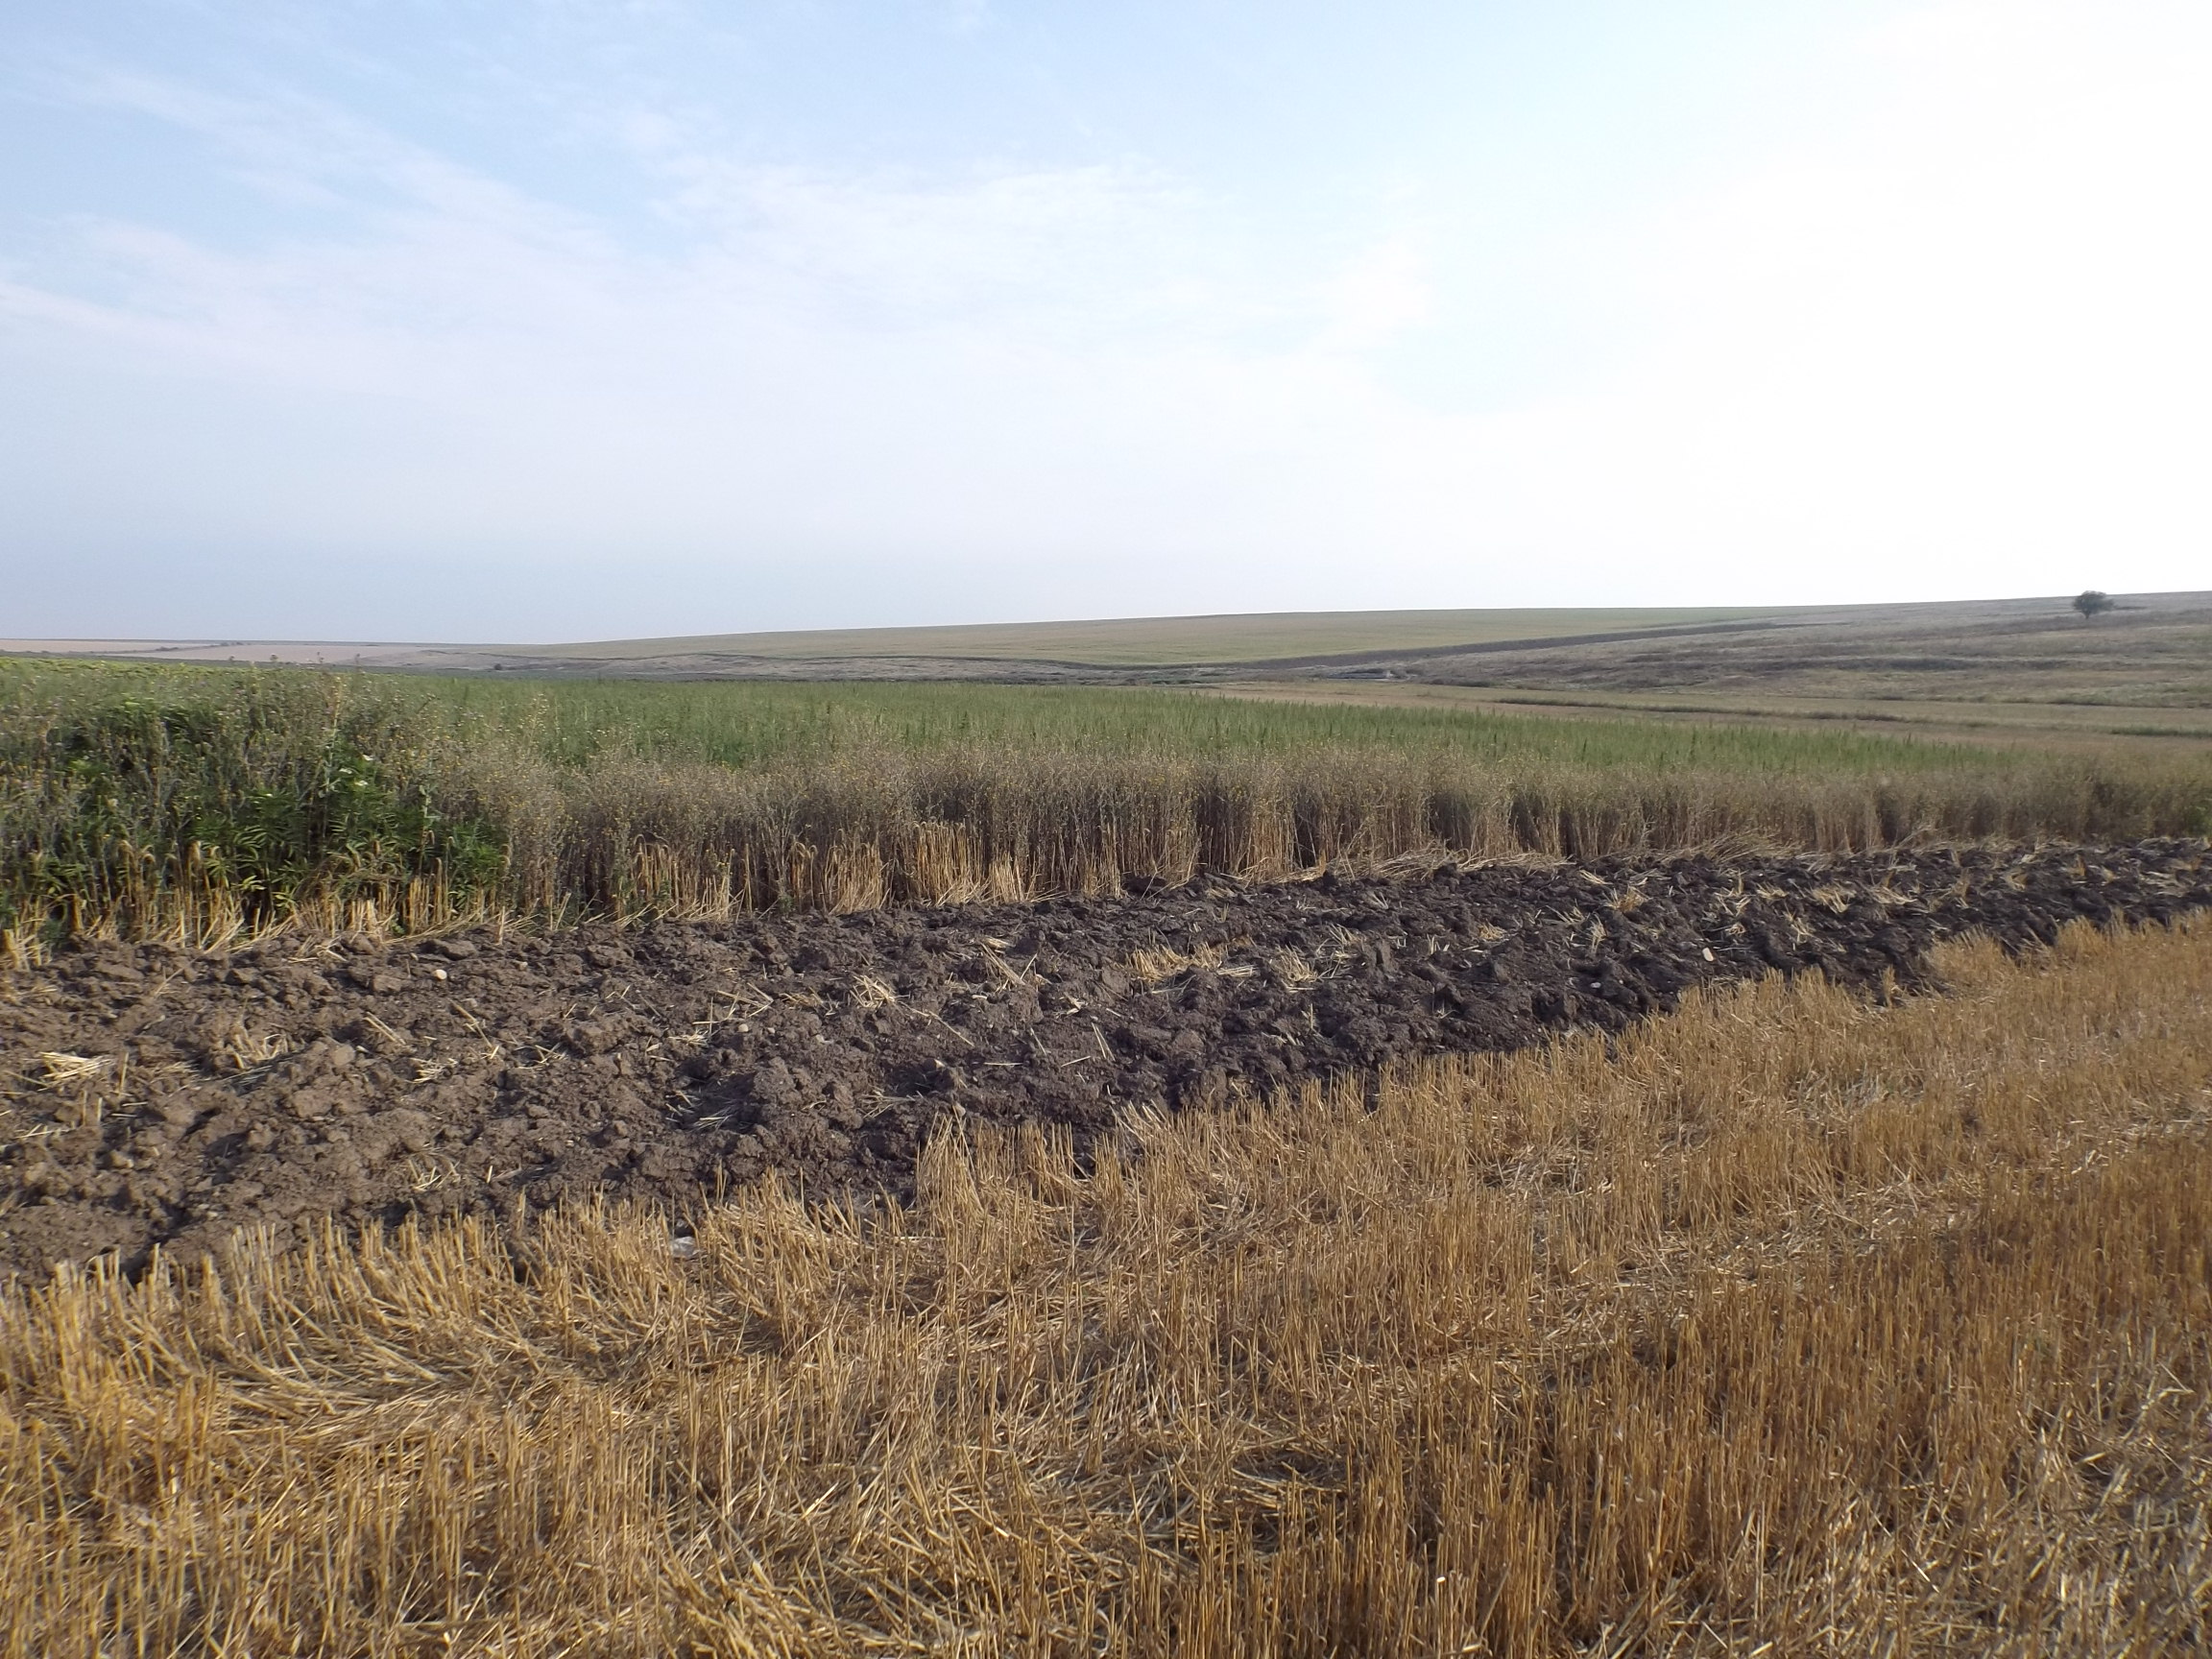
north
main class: Cropland
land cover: Common wheat
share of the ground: 10 - 25 %
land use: Agriculture (excluding fallow land and kitchen gardens)
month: July
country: BG
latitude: 43.5665
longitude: 27.4007
